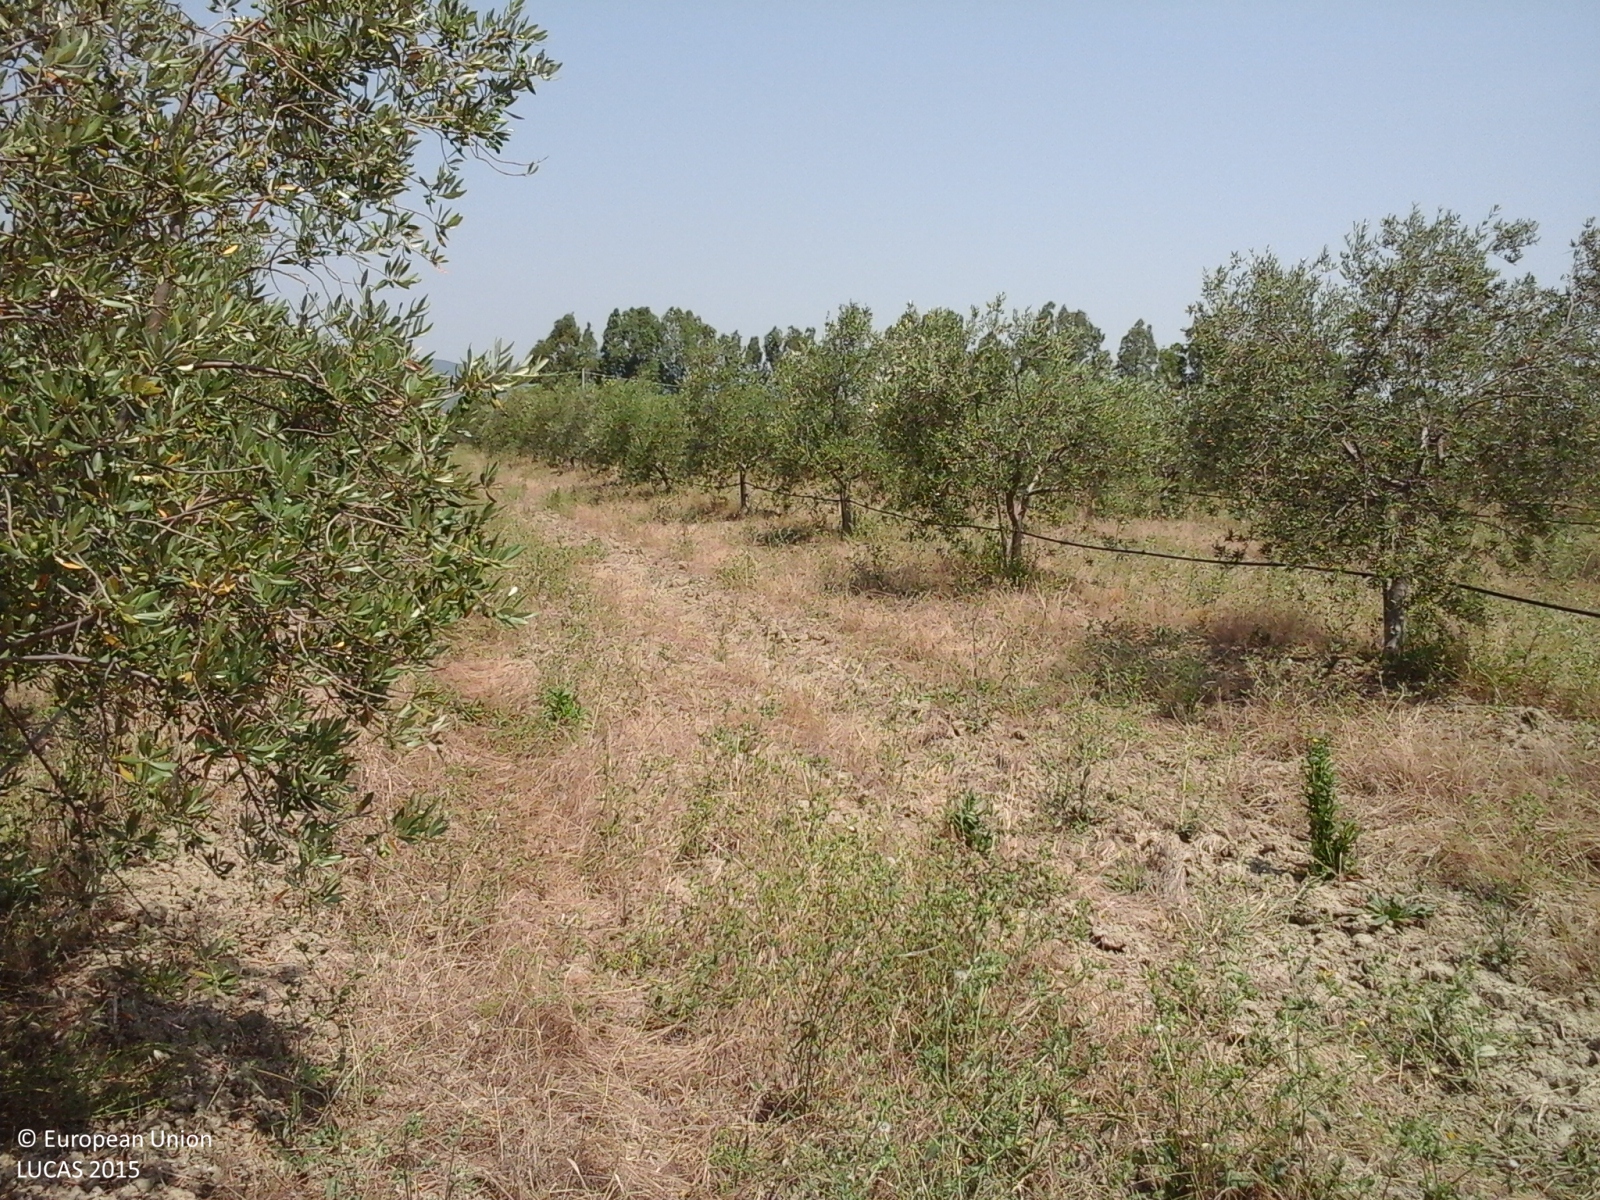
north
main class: Cropland
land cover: Olive groves
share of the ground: 50 - 75 %
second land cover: Grassland without tree/shrub cover
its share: 50 - 75 %
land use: Agriculture (excluding fallow land and kitchen gardens)
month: July
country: IT
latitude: 42.7576
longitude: 10.9865
